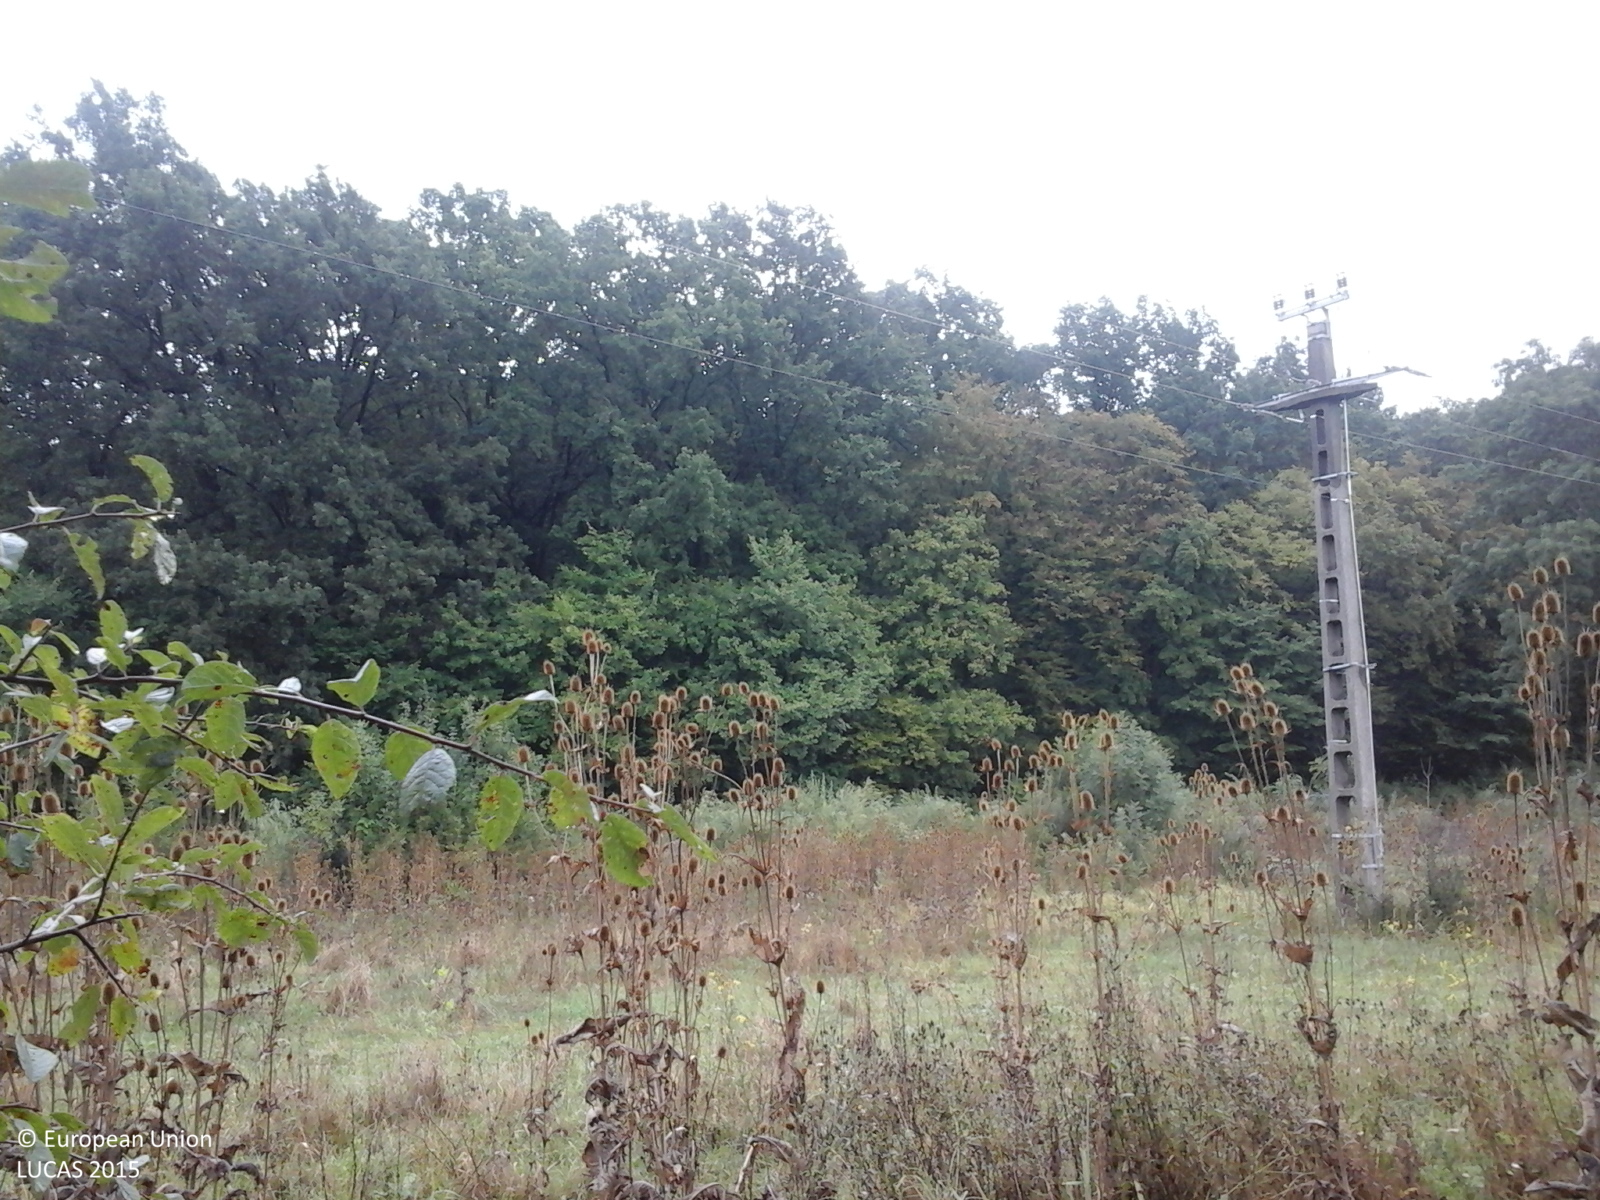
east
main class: Woodland
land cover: Broadleaved woodland
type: non-riverine alder, birch or aspen forest
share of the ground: > 75 %
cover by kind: broadleaved forest trees 100 %
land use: Forestry
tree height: > 5 m
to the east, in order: Broadleaved woodland; Rivers and streams; Broadleaved woodland; Grassland without tree/shrub cover; Electric lines; Grassland with sparse tree/shrub cover; Lines of trees; Paved roads, cycling and walking lanes; Ditches and canals; Broadleaved woodland
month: September
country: RO
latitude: 46.9657
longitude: 21.9935
